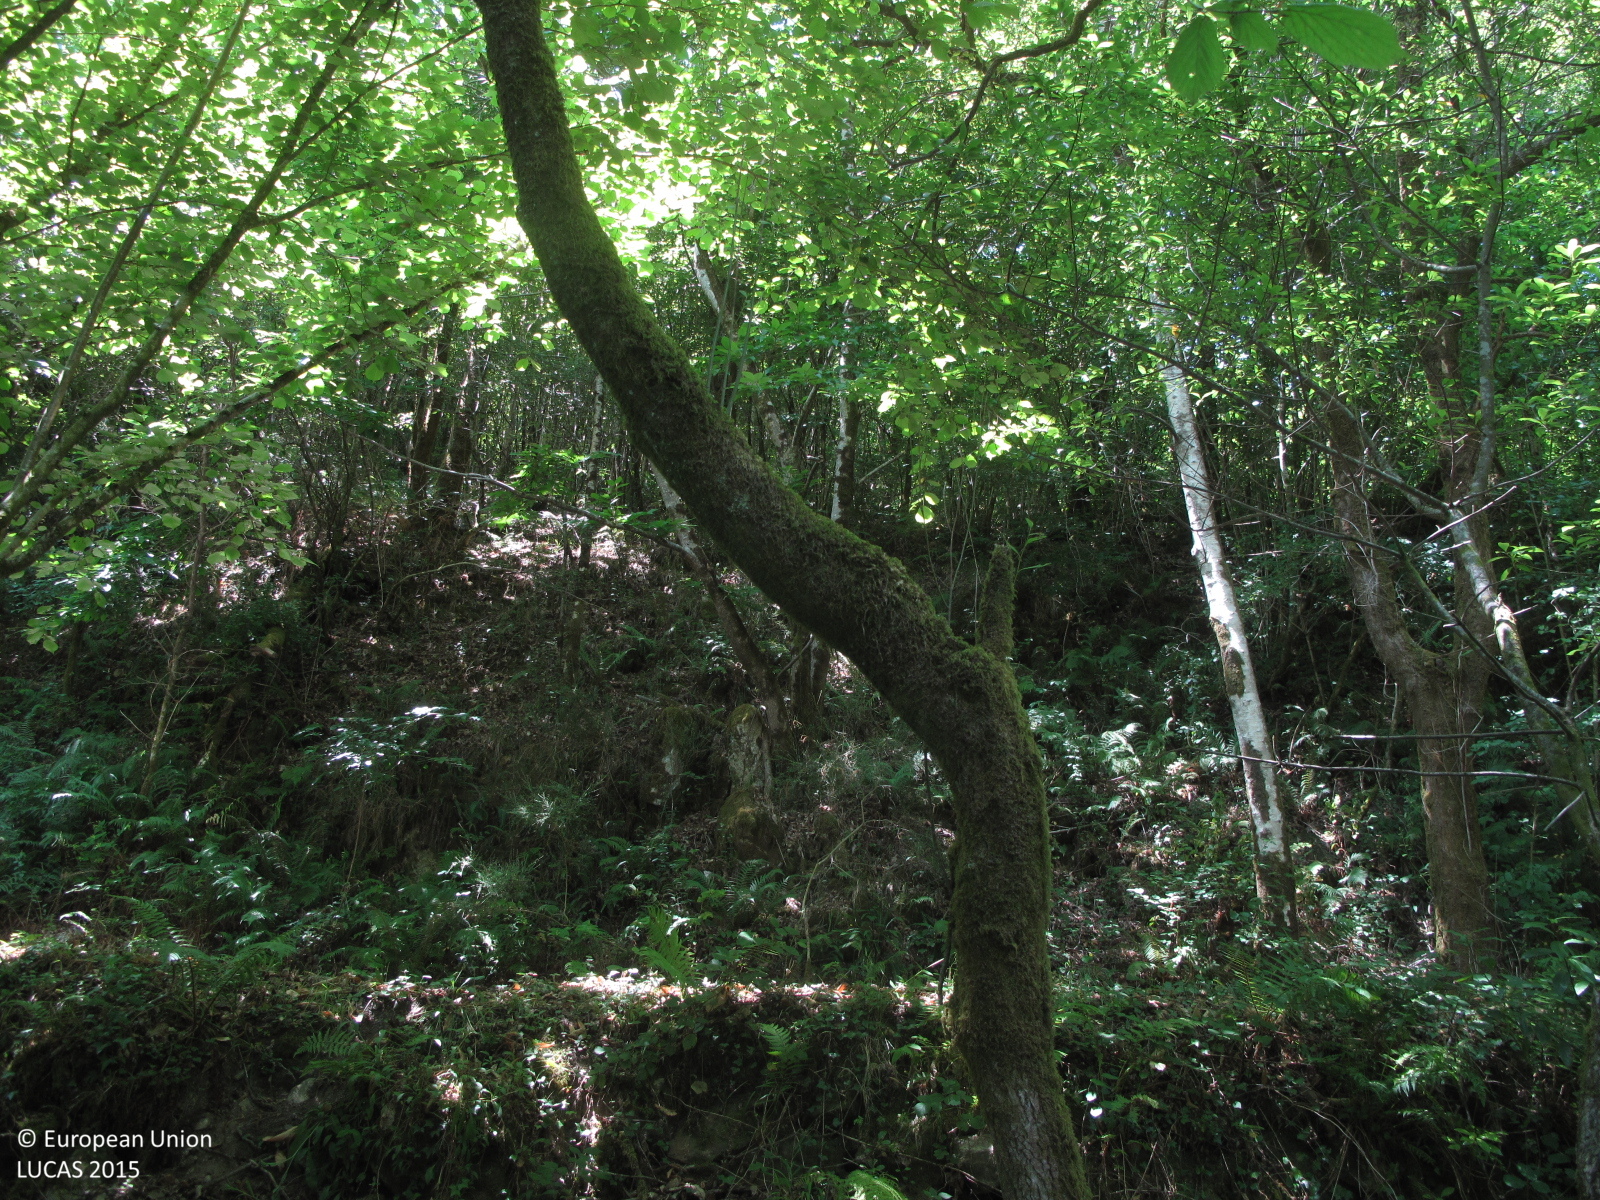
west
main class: Woodland
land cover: Broadleaved woodland
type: acidophilous oak and oak-birch forest
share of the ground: > 75 %
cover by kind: broadleaved forest trees 100 %
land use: Semi-natural and natural areas not in use
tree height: > 5 m
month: July
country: ES
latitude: 43.4085
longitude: -8.0899
